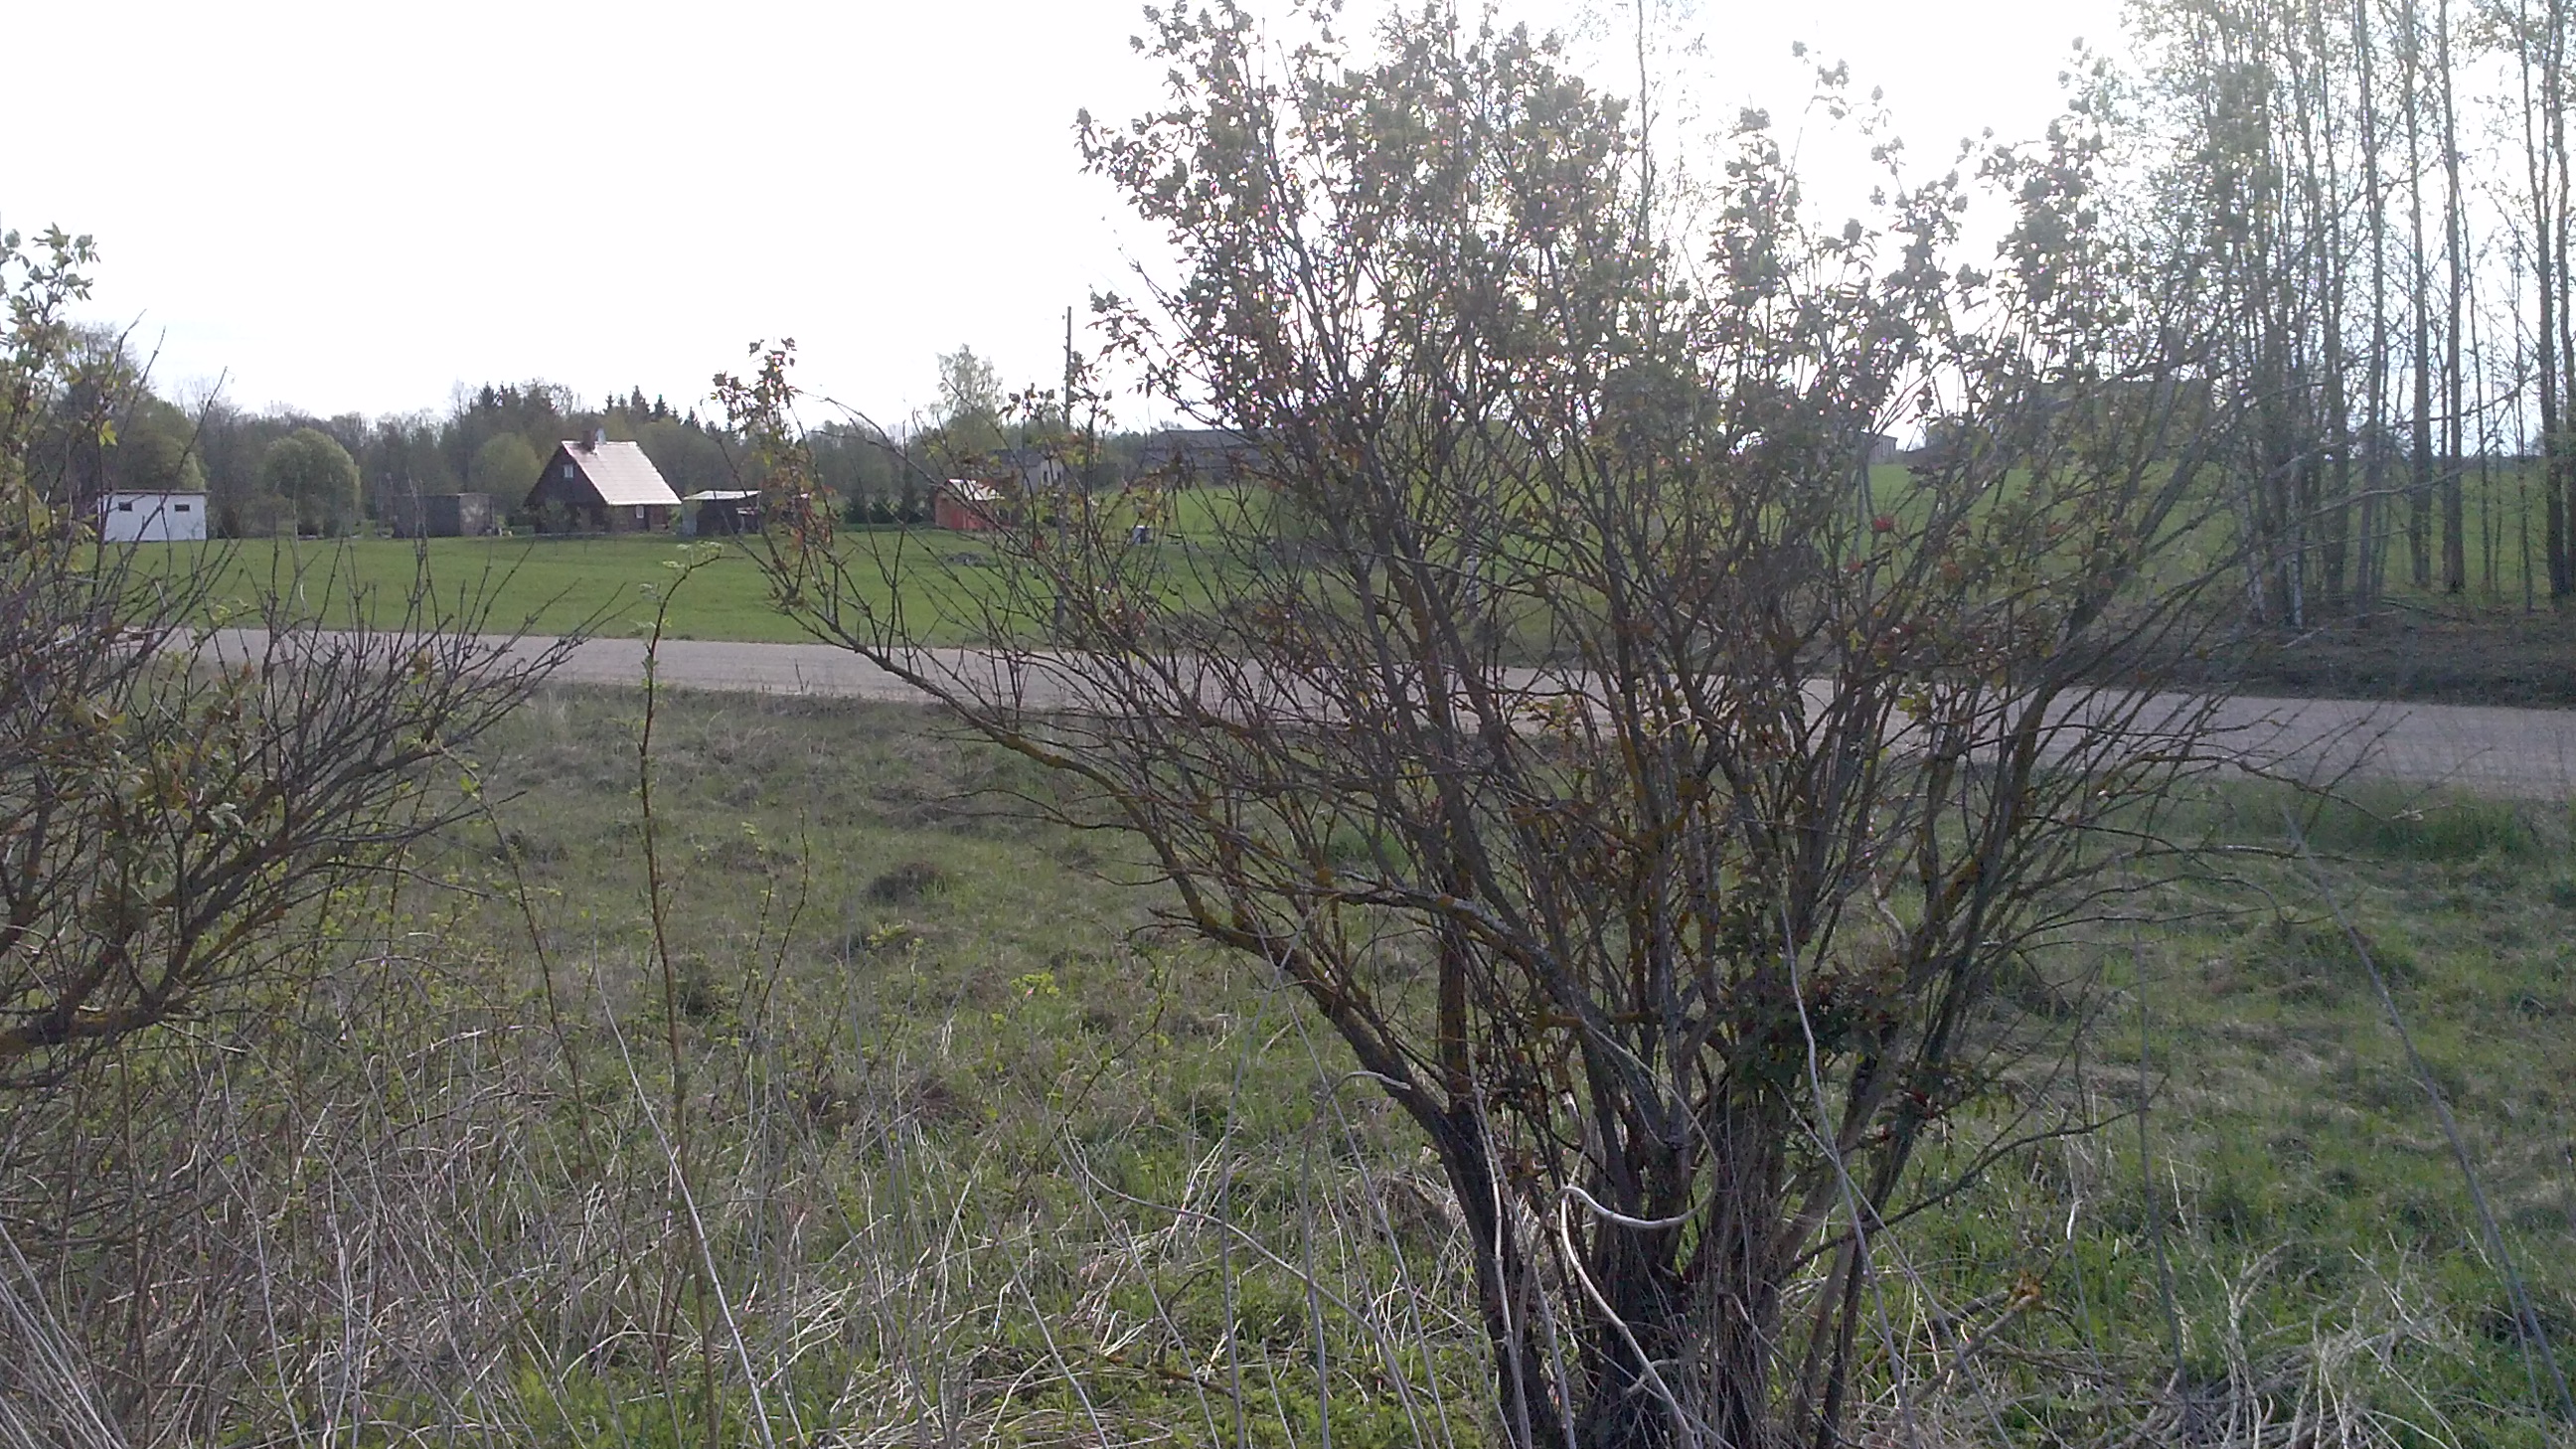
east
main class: Woodland
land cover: Broadleaved woodland
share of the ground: 10 - 25 %
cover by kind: herbaceous plants 80 %, broadleaved forest trees 20 %
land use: Semi-natural and natural areas not in use
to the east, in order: Broadleaved woodland; Grassland without tree/shrub cover; Paved roads, cycling and walking lanes; Barley; Electric lines; Inland fresh water bodies; Barley; Grassland with sparse tree/shrub cover; Barley; Tracks; Grassland without tree/shrub cover
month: May
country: LV
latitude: 55.9142
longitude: 27.0795
